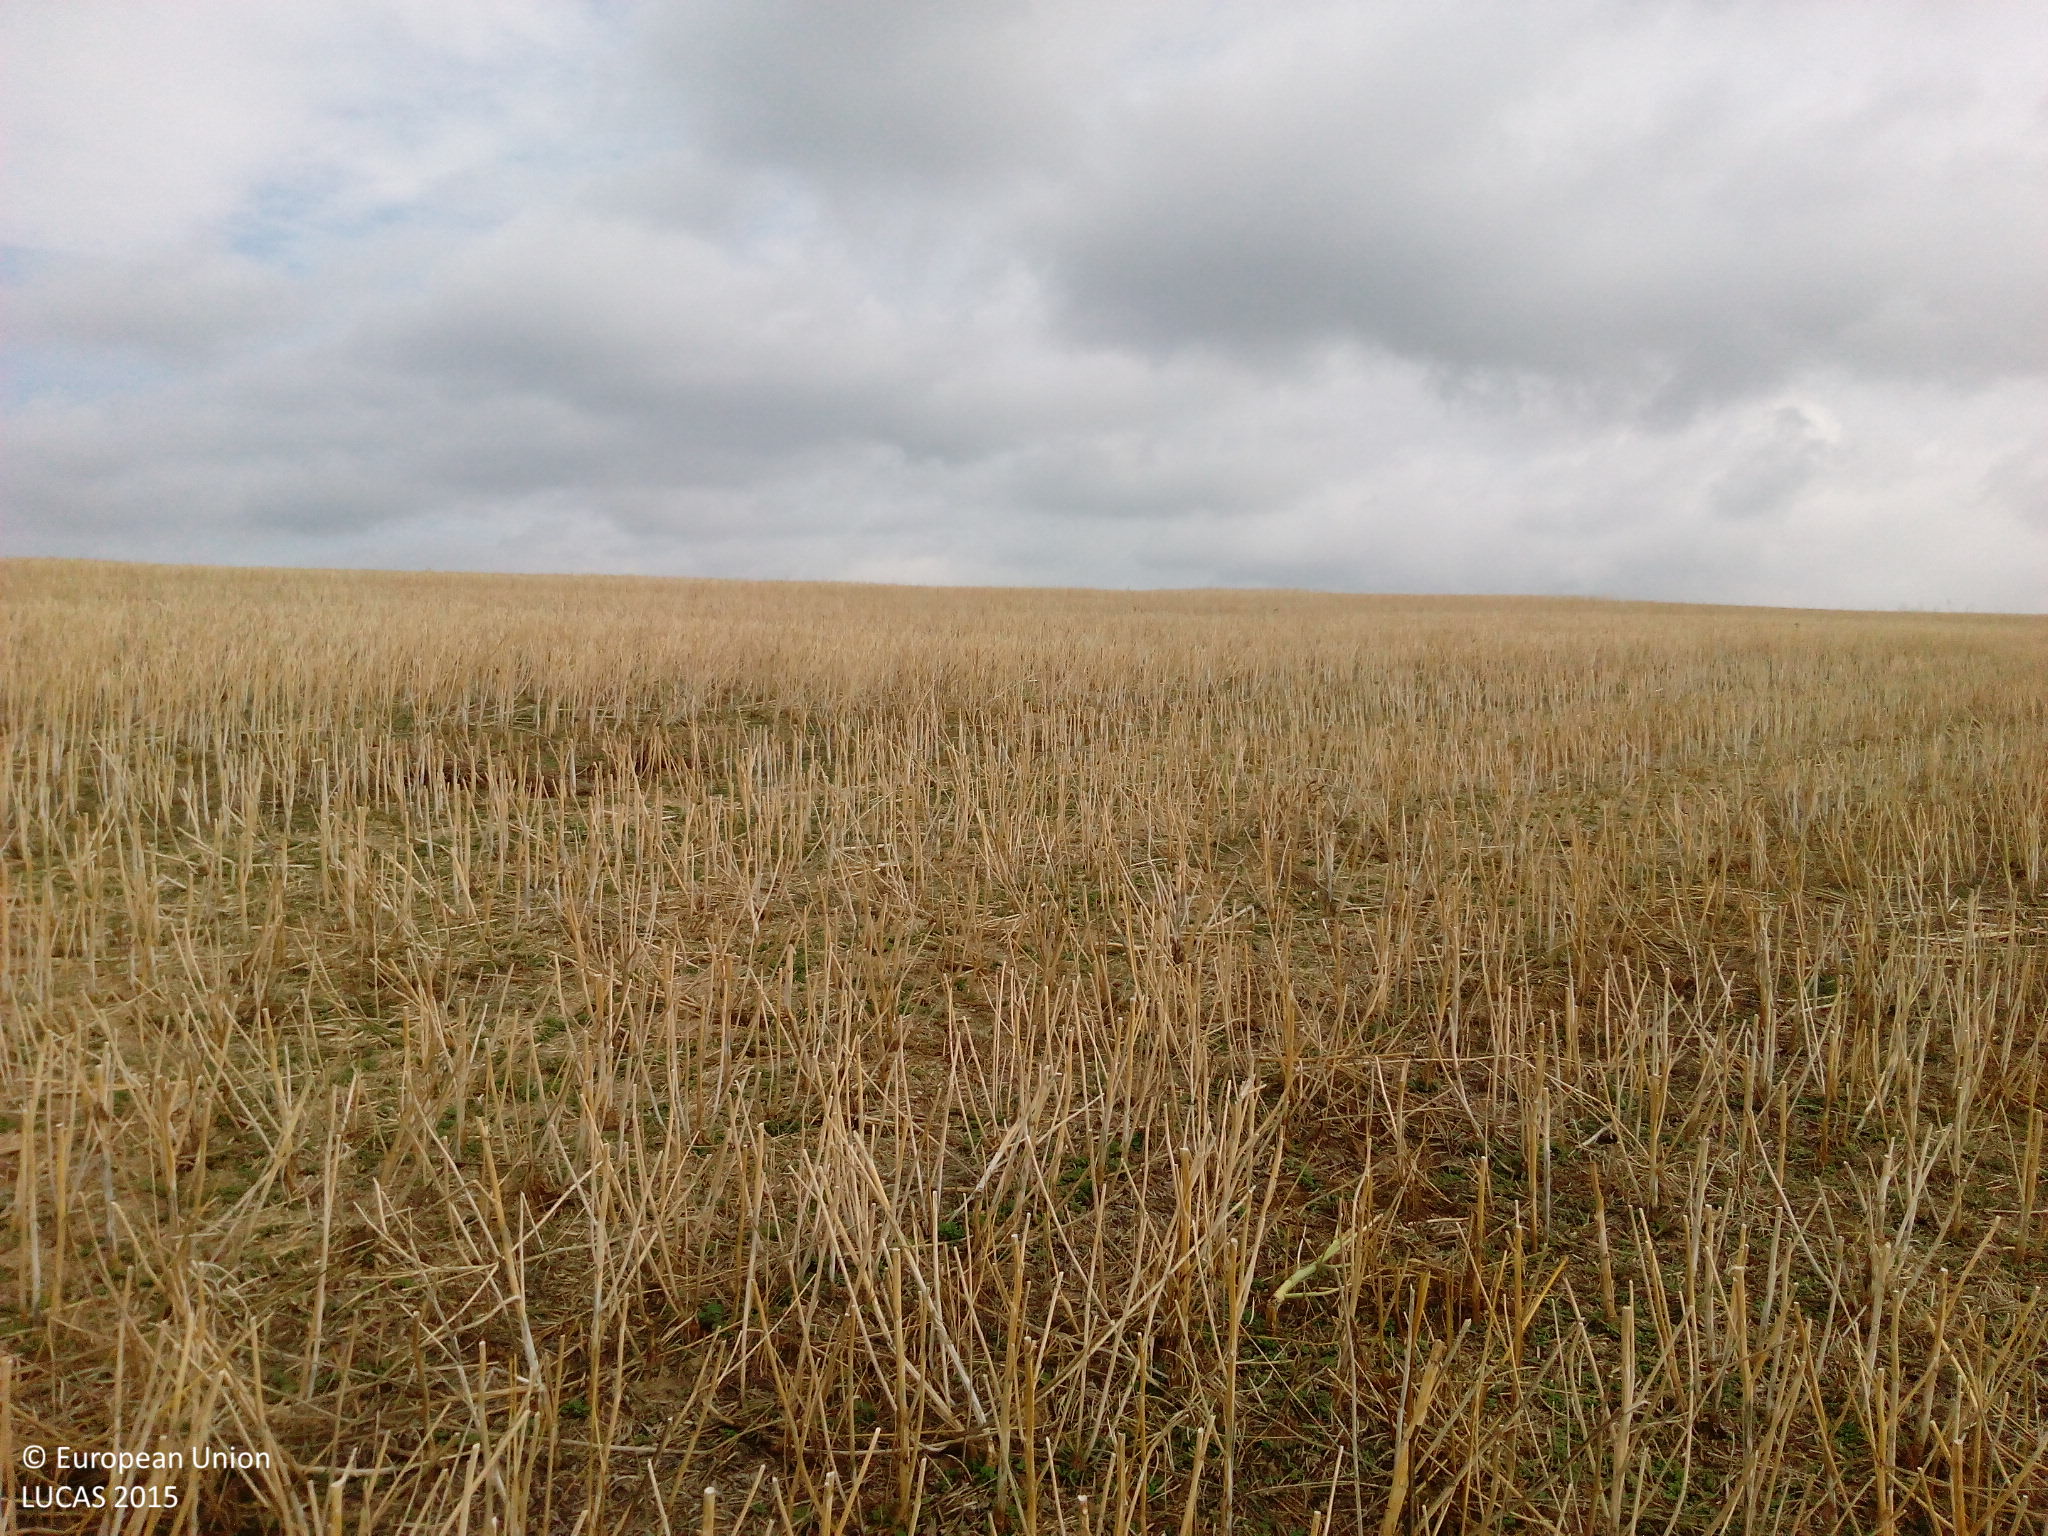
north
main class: Cropland
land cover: Rape and turnip rape
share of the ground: < 10 %
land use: Agriculture (excluding fallow land and kitchen gardens)
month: August
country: DE
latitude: 49.6901
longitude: 7.5468
